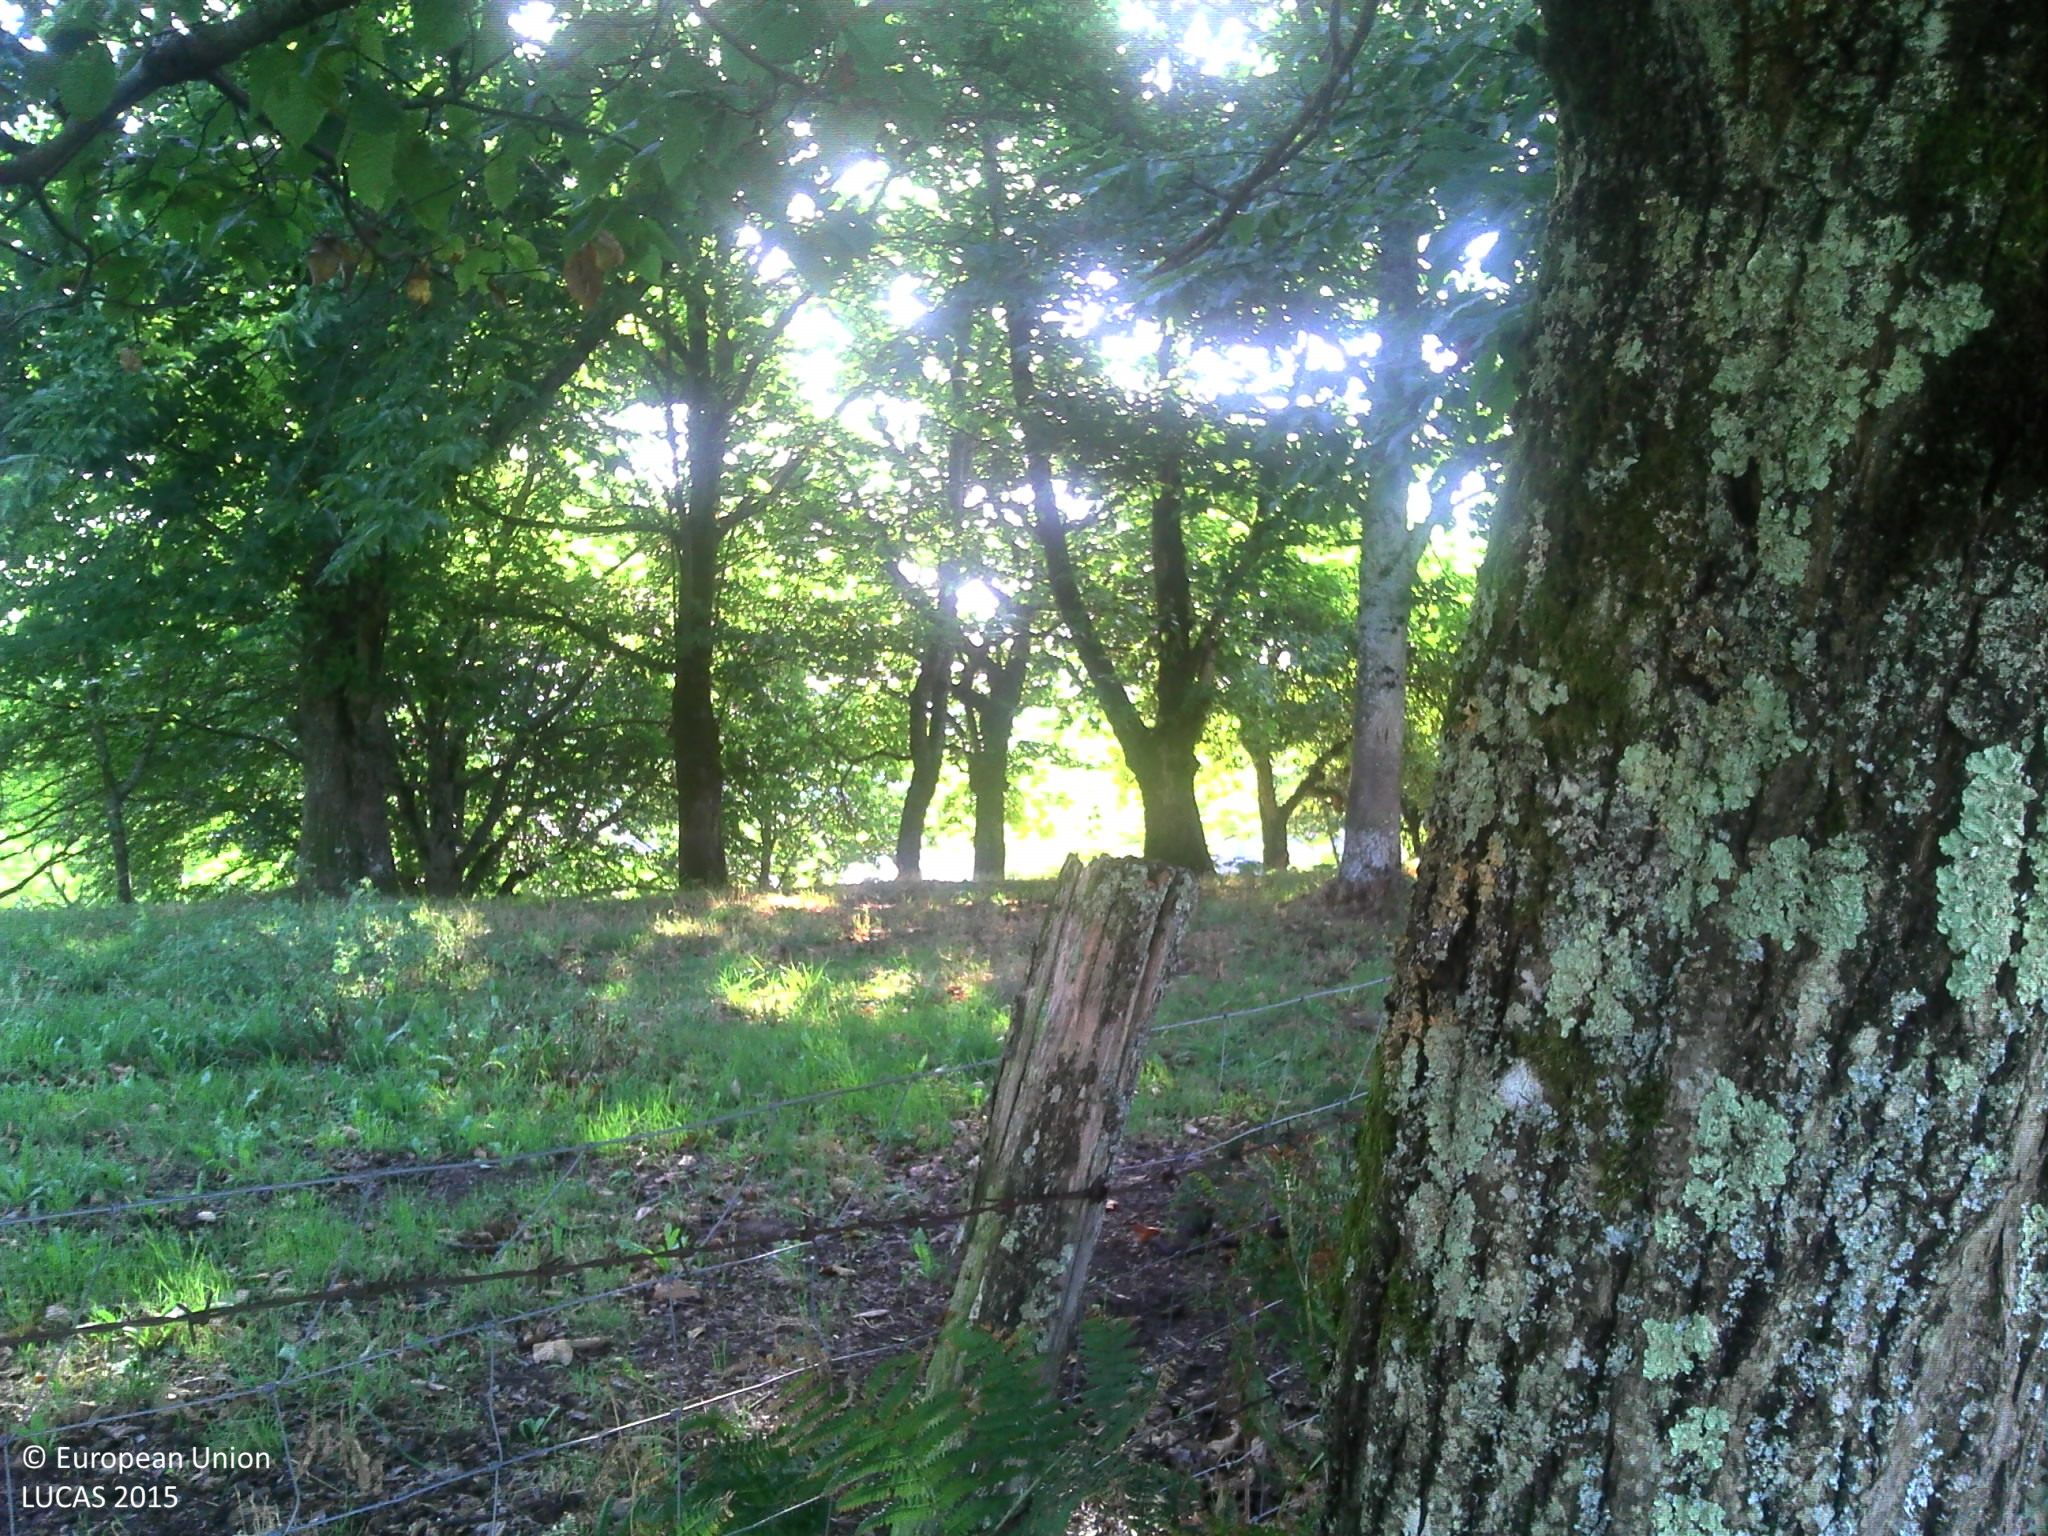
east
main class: Woodland
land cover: Broadleaved woodland
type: thermophilous deciduous forest
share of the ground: 25 - 50 %
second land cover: Grassland without tree/shrub cover
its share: > 75 %
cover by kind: herbaceous plants 60 %, broadleaved forest trees 40 %
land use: Forestry
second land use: Agriculture (excluding fallow land and kitchen gardens)
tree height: > 5 m
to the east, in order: Broadleaved woodland; Grassland without tree/shrub cover; Fences; Abandoned hedges; Grass margins; Paved roads, cycling and walking lanes; Grass margins; Fences; Lines of trees; Electric lines; Grassland without tree/shrub cover; Electric lines; Grassland without tree/shrub cover; Fences; Grassland without tree/shrub cover
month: August
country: FR
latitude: 45.2892
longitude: 1.5158
